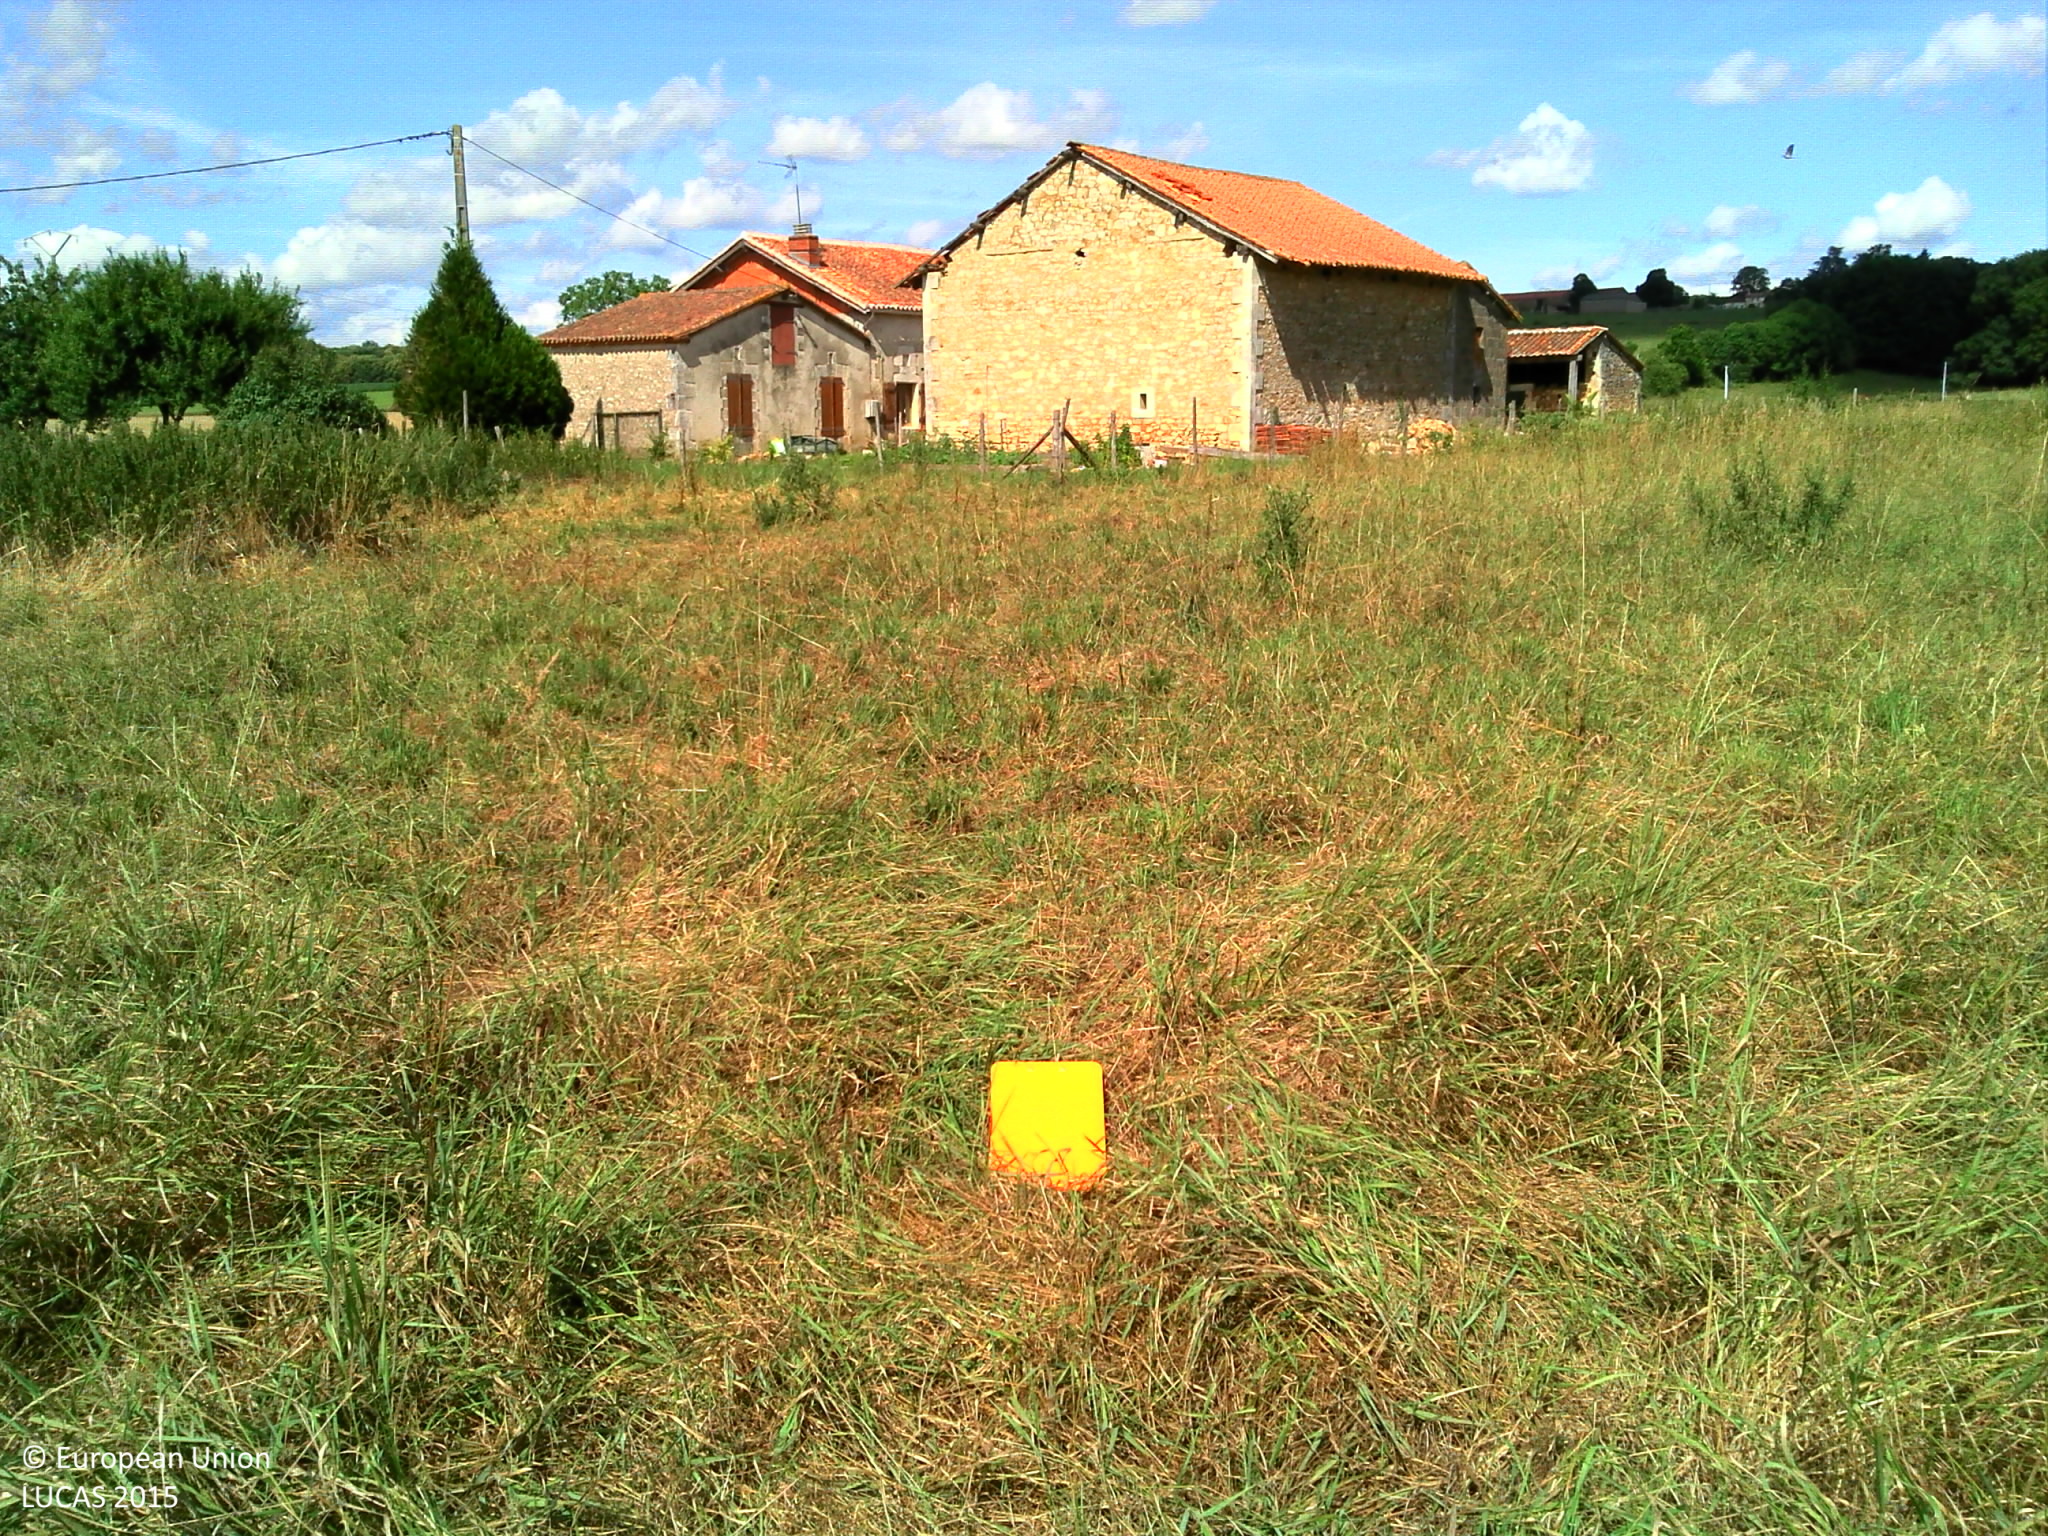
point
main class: Grassland
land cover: Grassland without tree/shrub cover
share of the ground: > 75 %
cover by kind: herbaceous plants 100 %
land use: Agriculture (excluding fallow land and kitchen gardens)
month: June
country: FR
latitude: 45.7047
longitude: 0.4423
